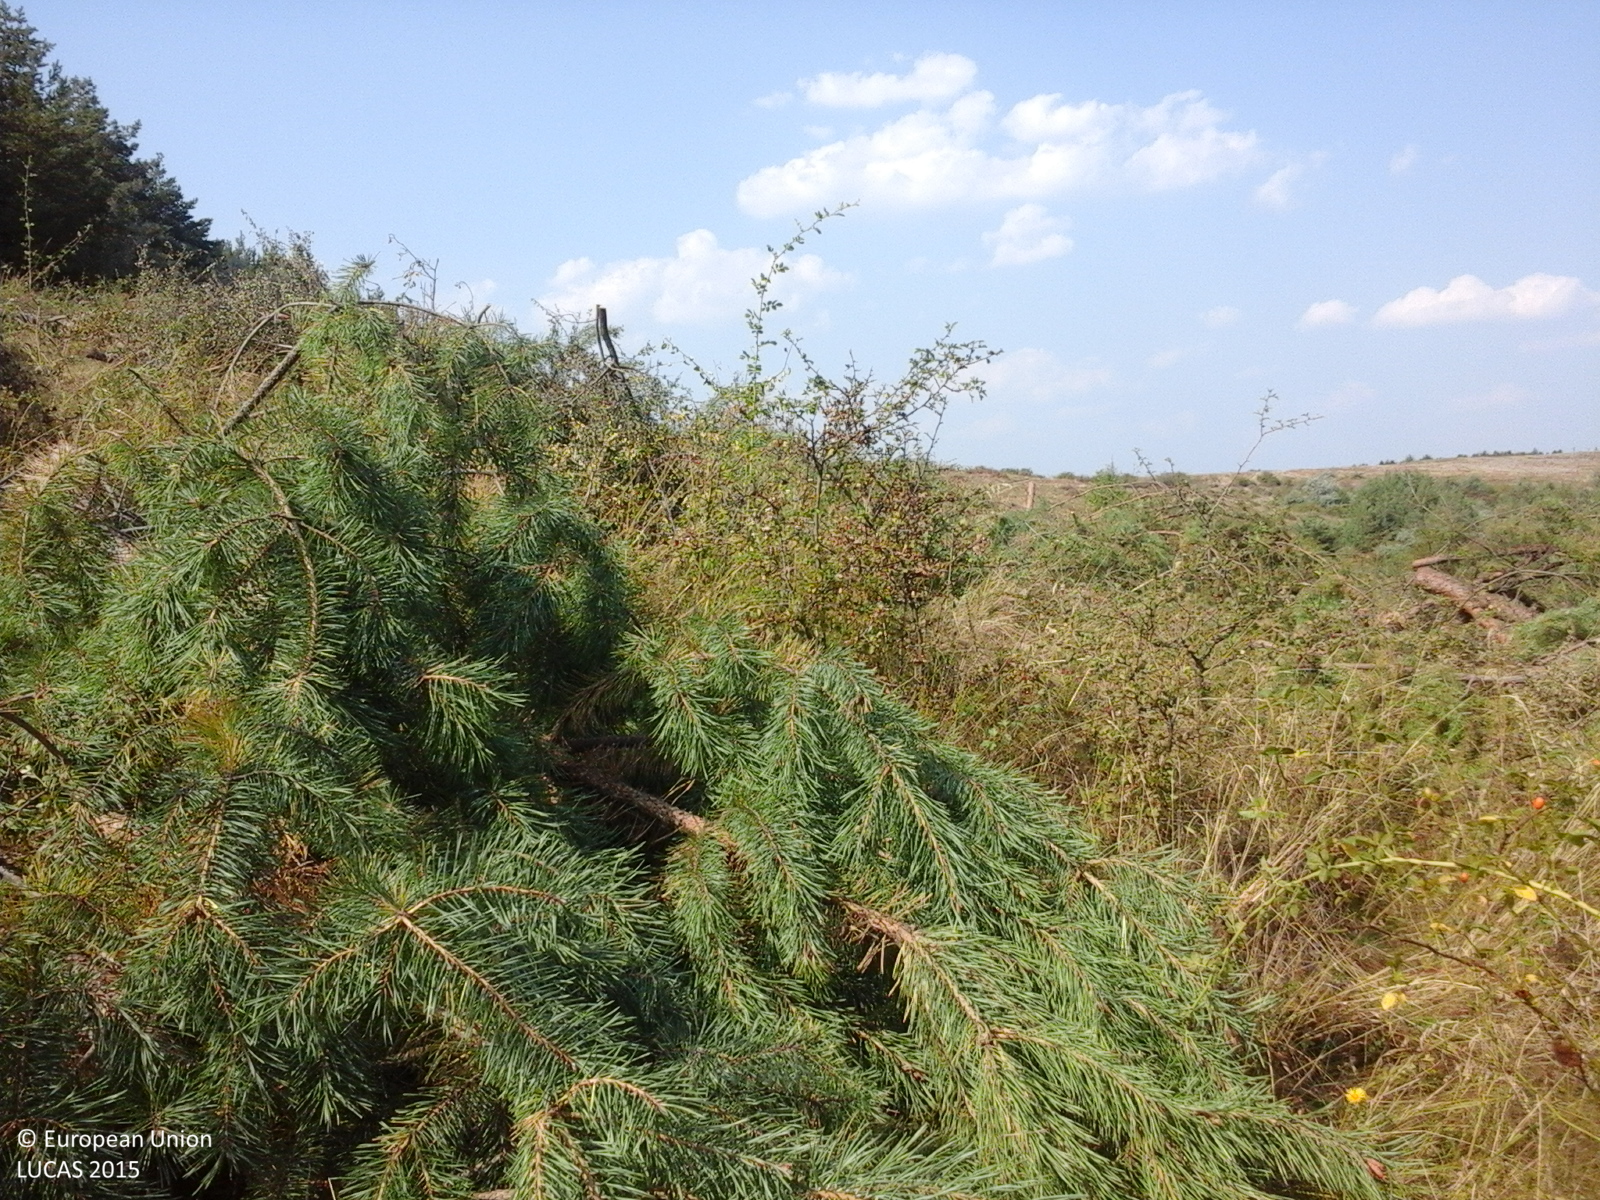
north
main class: Grassland
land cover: Grassland with sparse tree/shrub cover
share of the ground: > 75 %
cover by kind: herbaceous plants 85 %, shrubs 10 %, broadleaved forest trees 5 %
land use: Forestry
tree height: < 5 m
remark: Clear cut
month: September
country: RO
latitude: 47.1226
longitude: 24.1482
